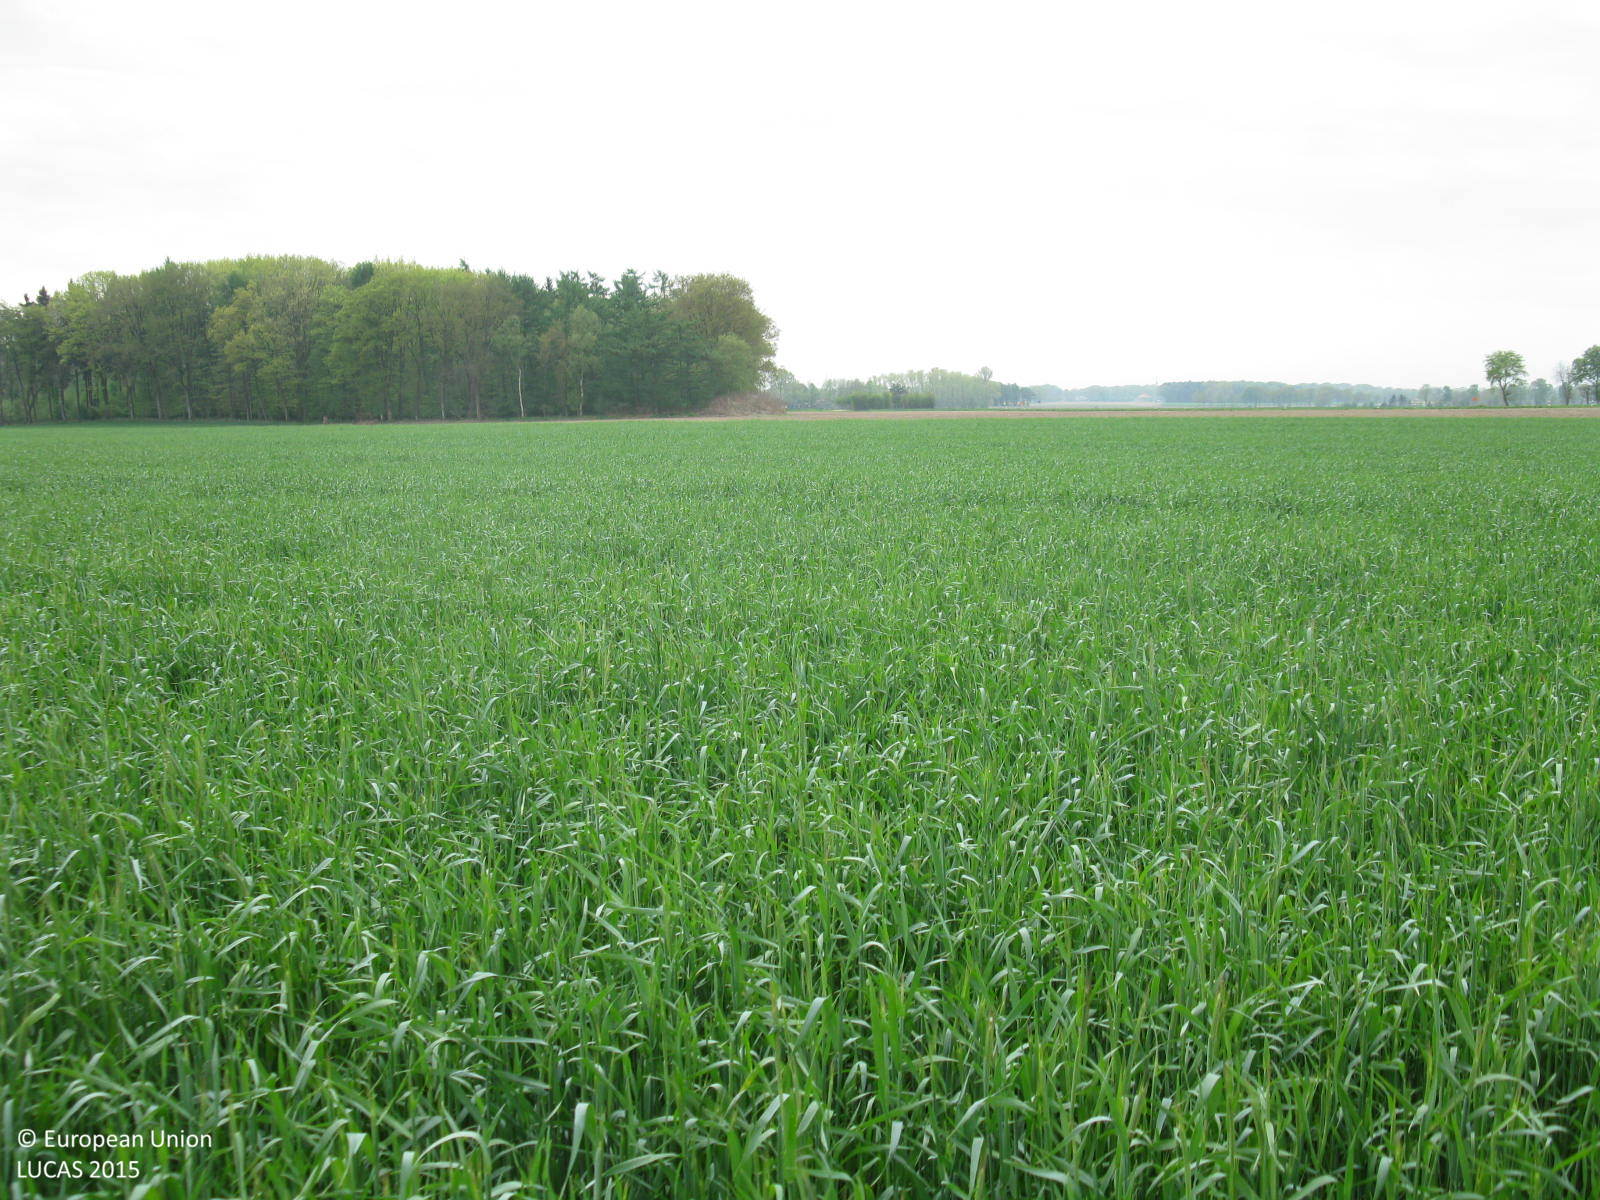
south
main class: Cropland
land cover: Rye
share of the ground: > 75 %
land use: Agriculture (excluding fallow land and kitchen gardens)
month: May
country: DE
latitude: 52.8450
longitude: 7.9368
